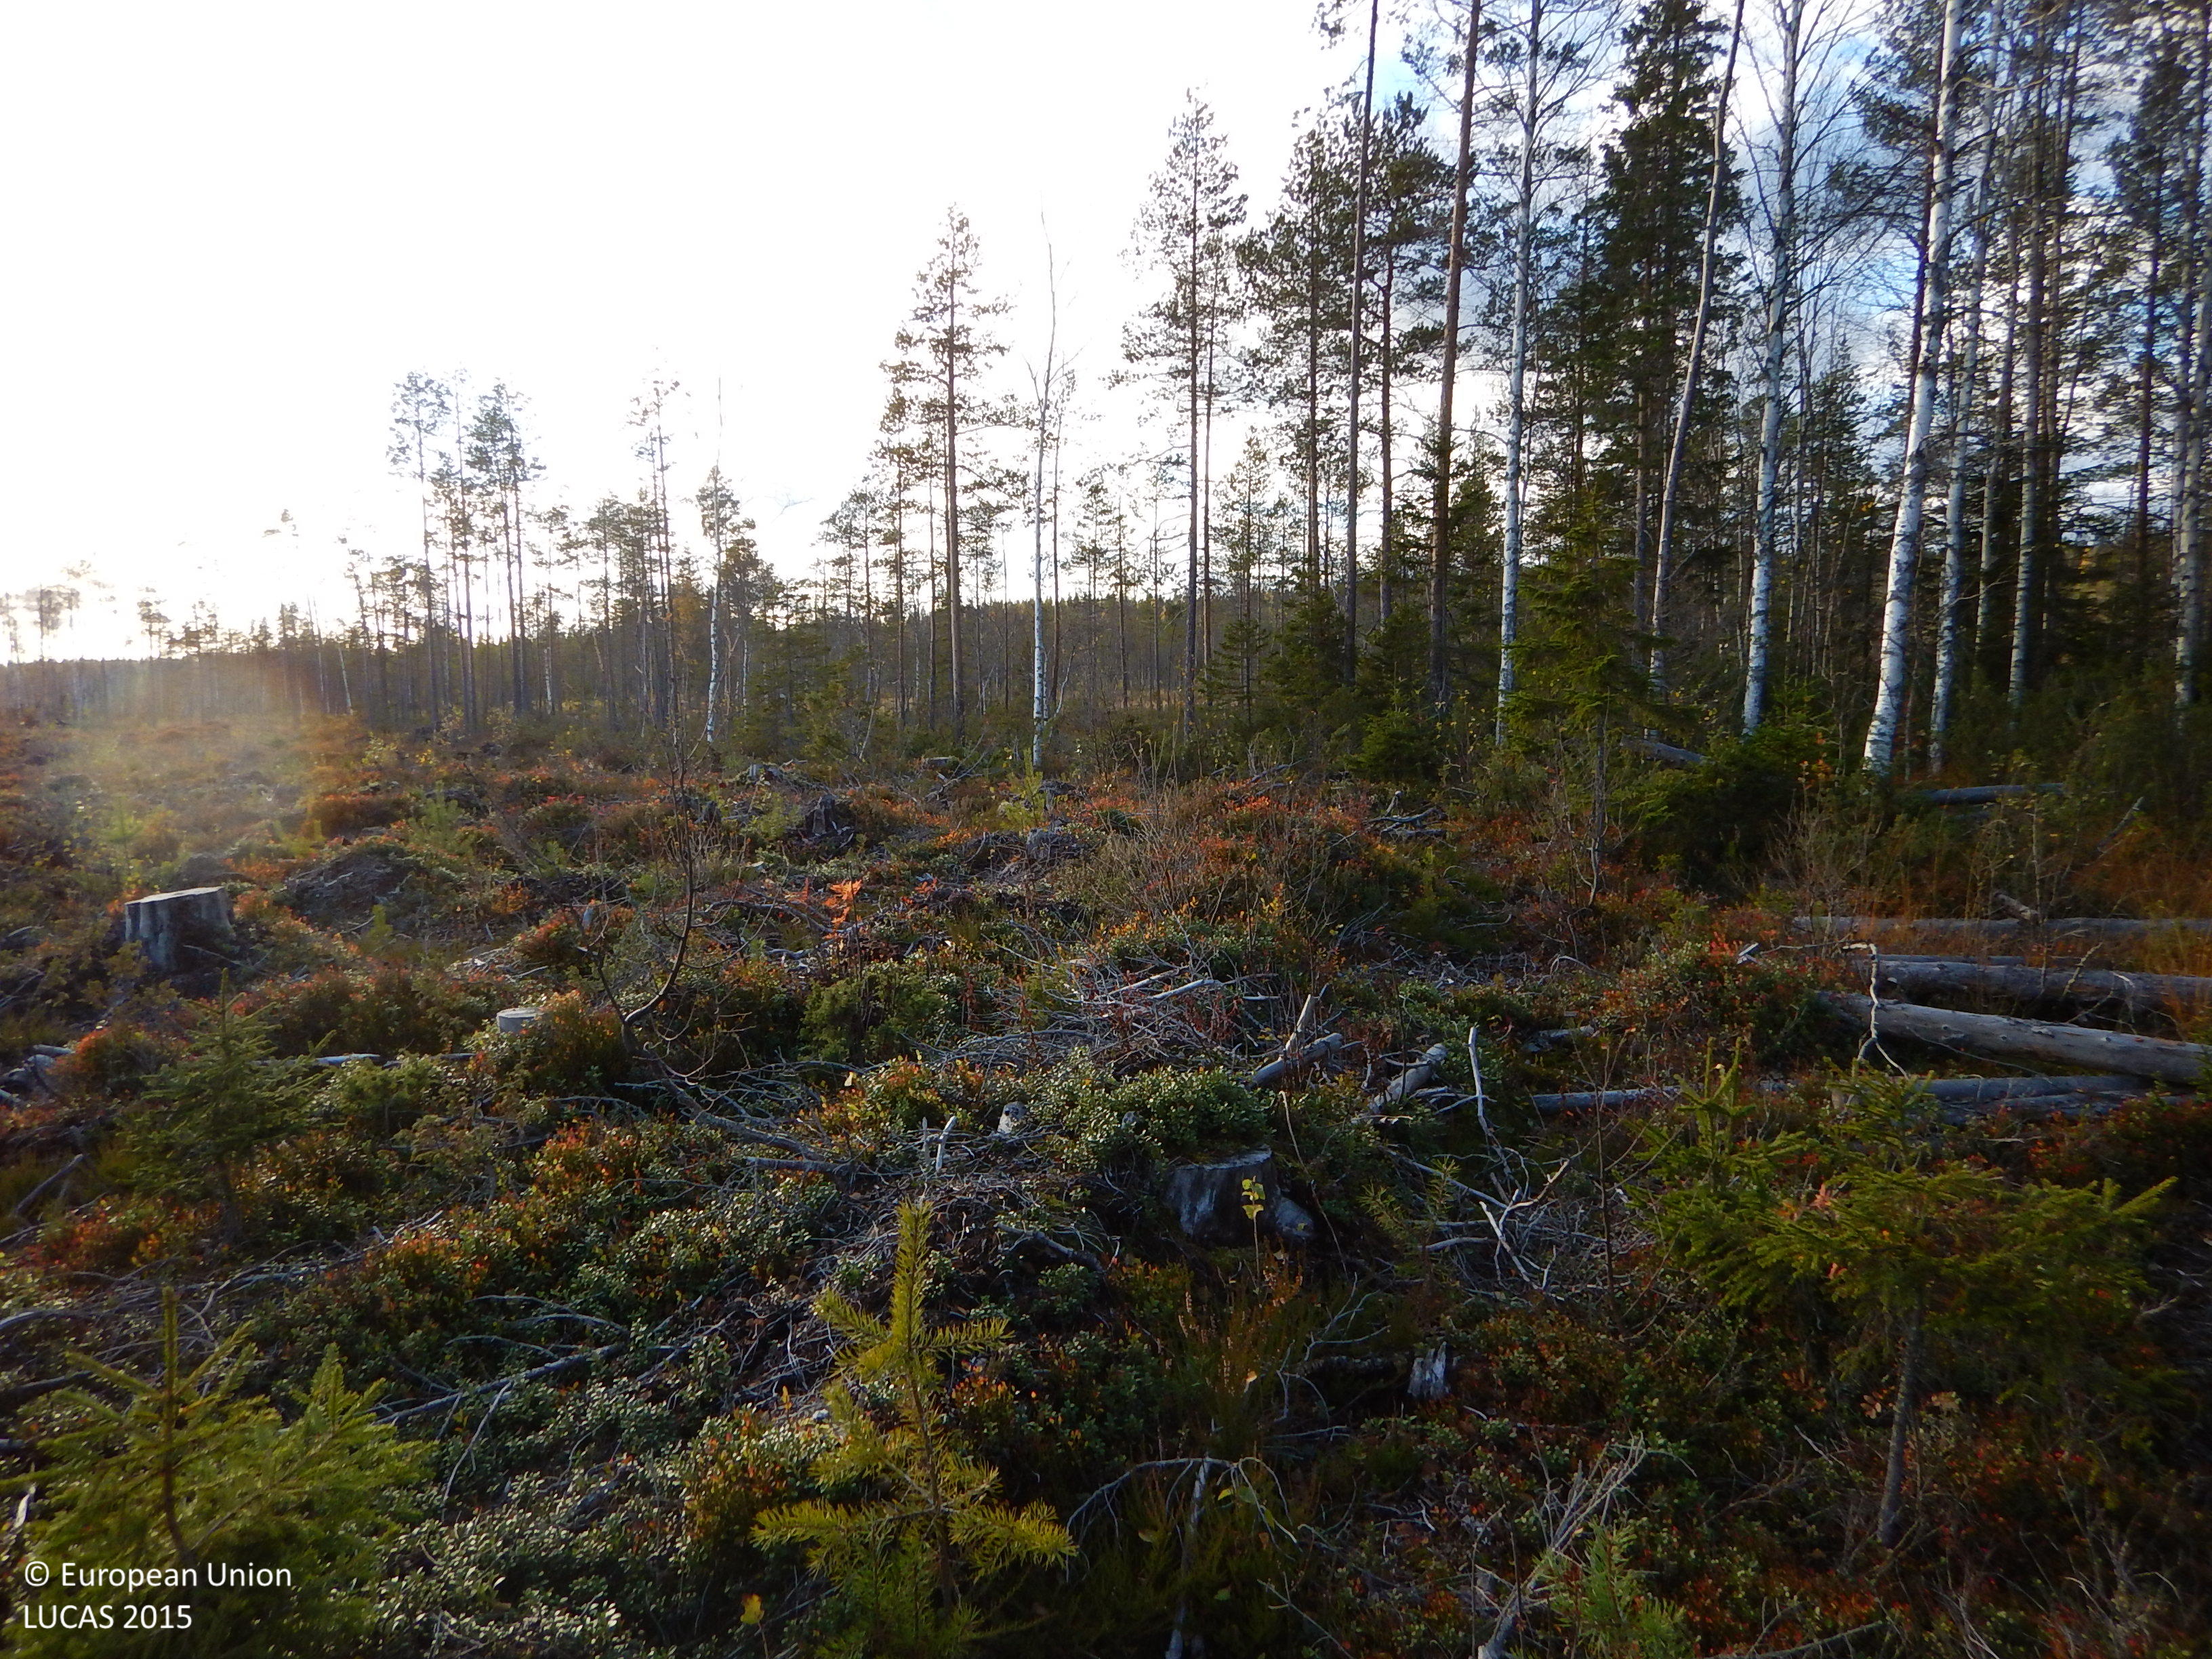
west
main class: Woodland
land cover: Other mixed woodland
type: boreal forest
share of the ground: 10 - 25 %
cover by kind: herbaceous plants 40 %, shrubs 20 %, lichens and mosses 20 %, coniferous forest trees 15 %, broadleaved forest trees 5 %
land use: Forestry
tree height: < 5 m
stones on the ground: < 10 %
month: October
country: SE
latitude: 64.9812
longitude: 20.7608
